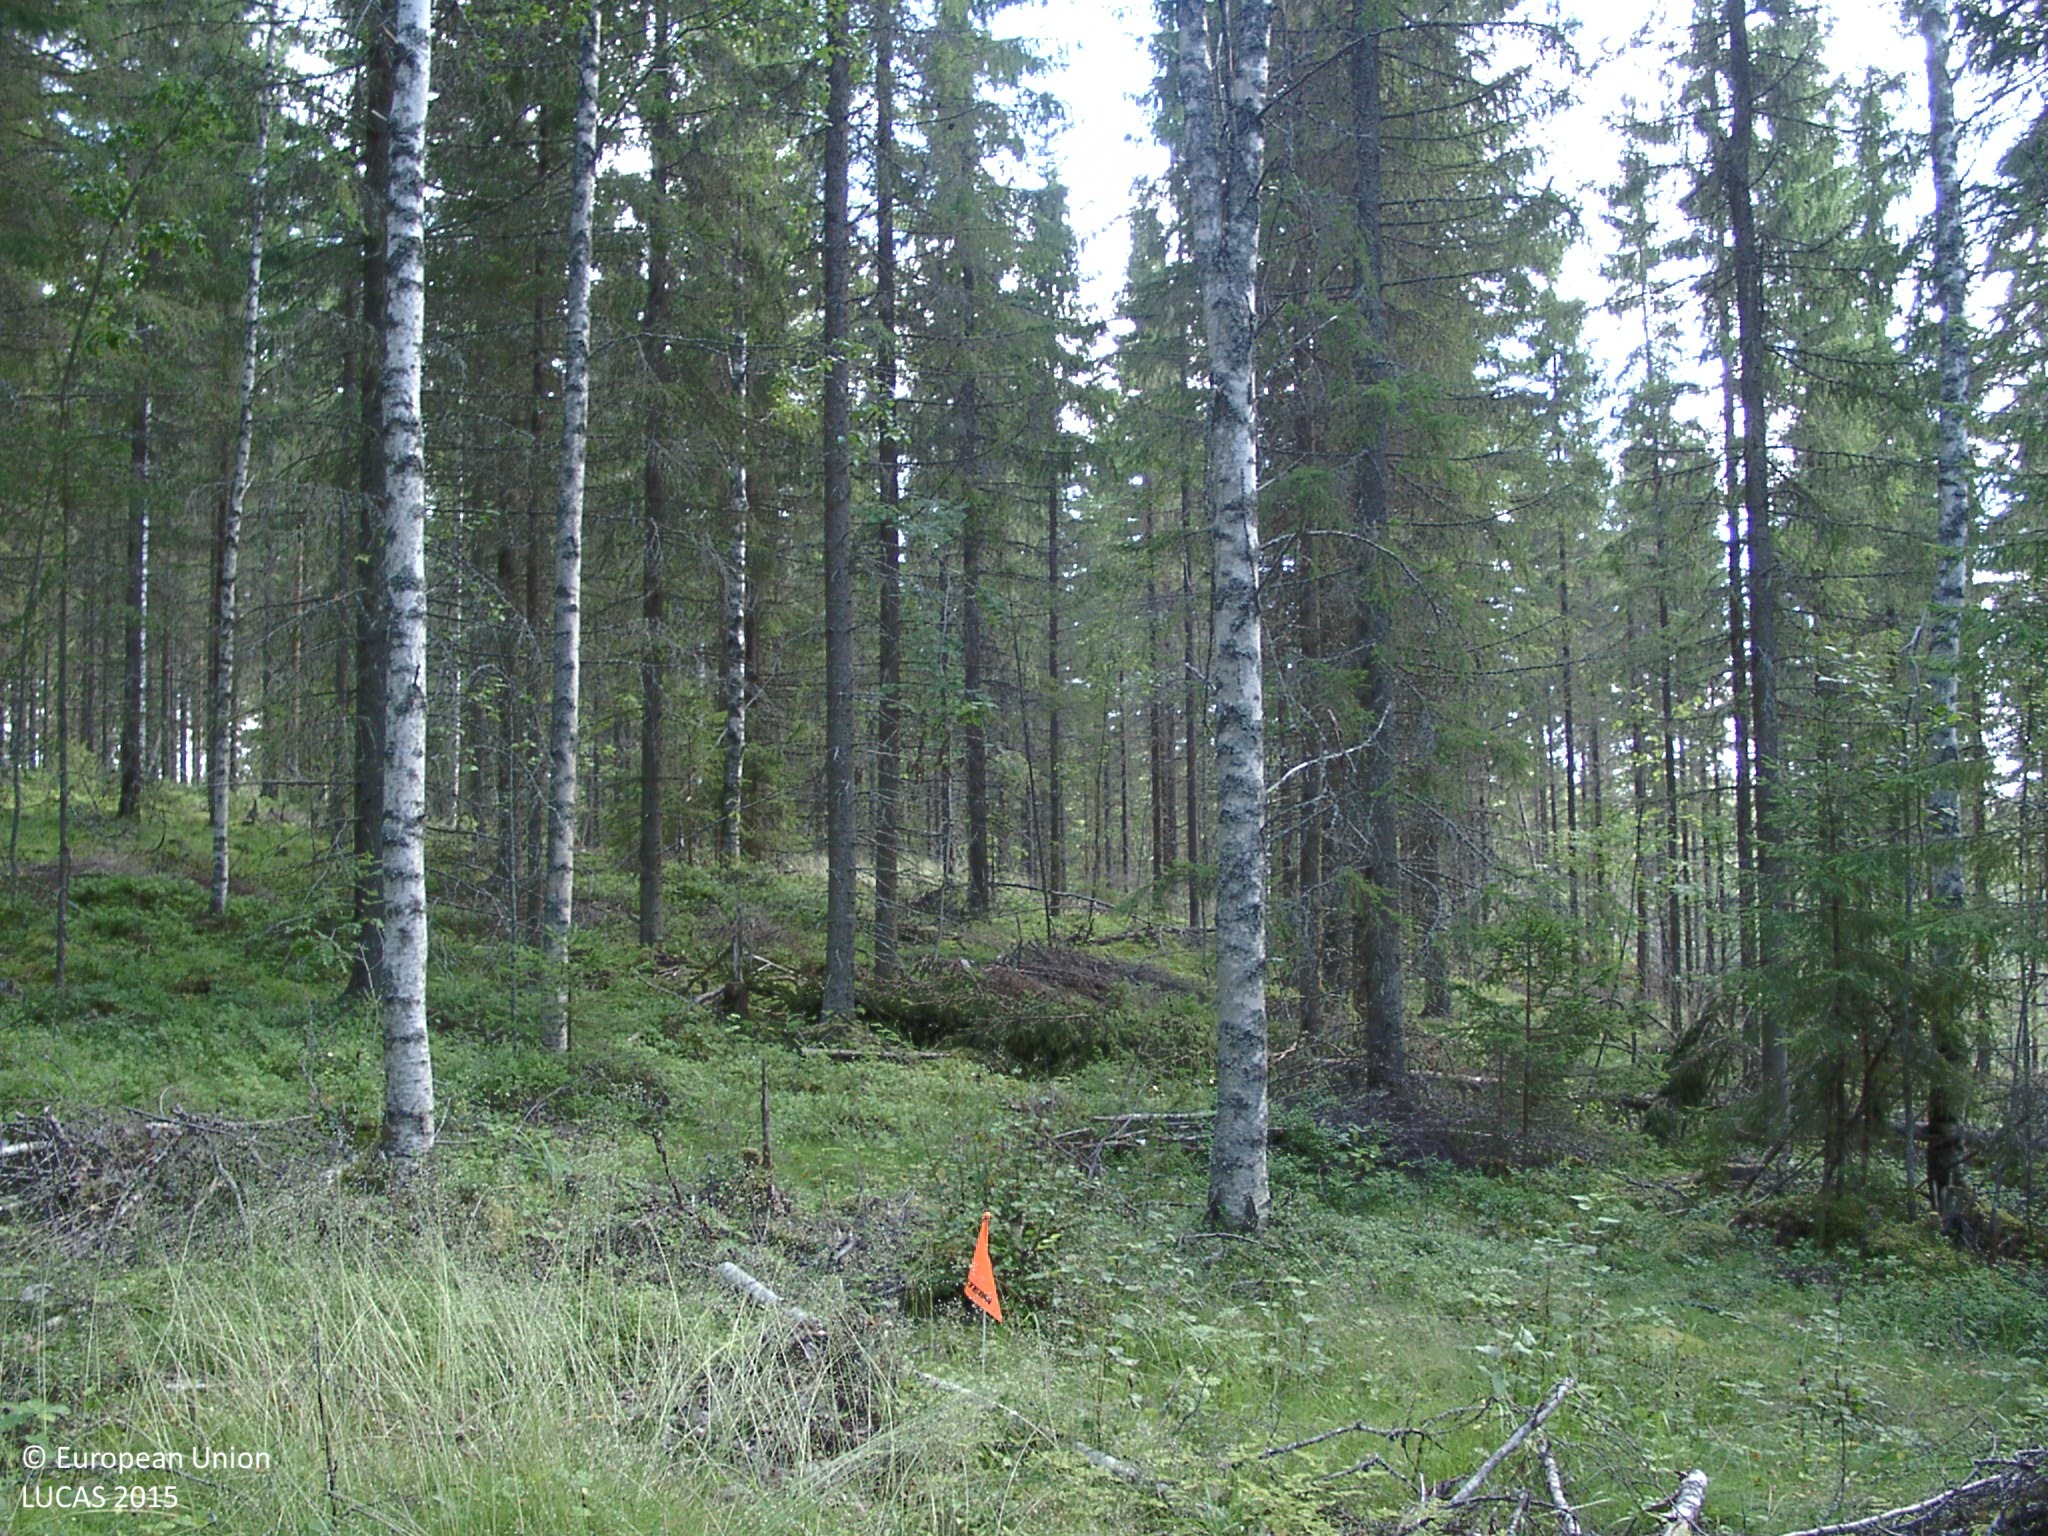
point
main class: Woodland
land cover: Spruce dominated mixed woodland
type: boreal forest
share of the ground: 50 - 75 %
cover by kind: coniferous forest trees 50 %, broadleaved forest trees 20 %, shrubs 15 %, lichens and mosses 10 %, herbaceous plants 5 %
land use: Forestry
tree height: > 5 m
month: August
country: FI
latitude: 62.9367
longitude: 25.0502
